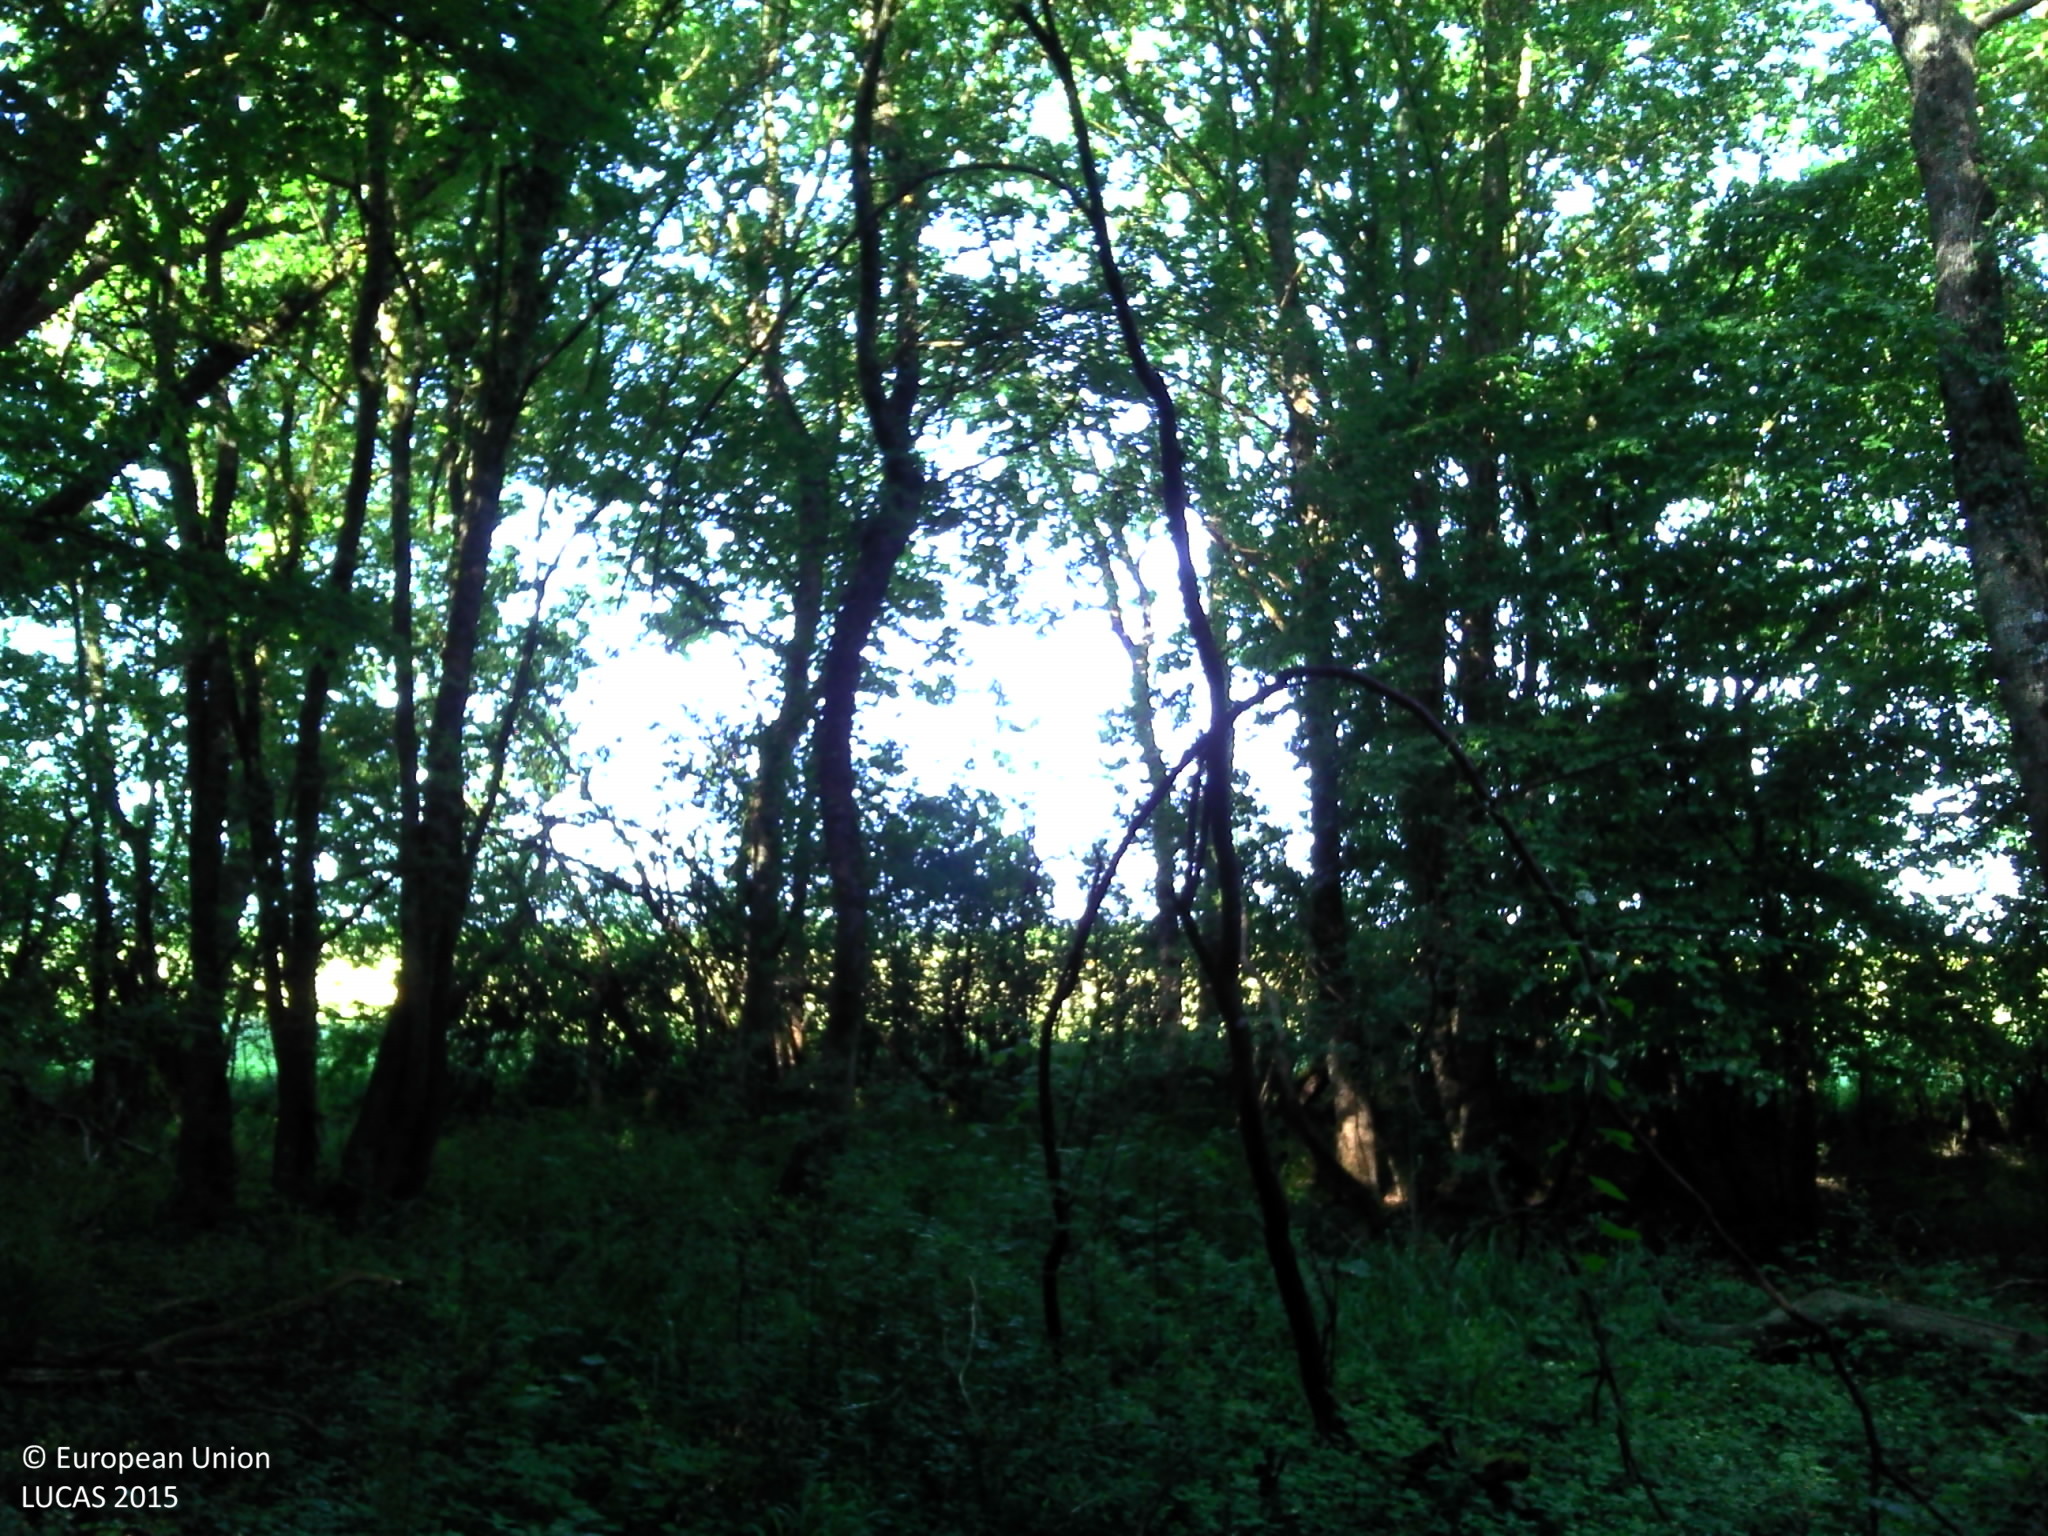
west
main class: Woodland
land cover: Broadleaved woodland
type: beech forest
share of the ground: > 75 %
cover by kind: broadleaved forest trees 90 %, herbaceous plants 10 %
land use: Forestry
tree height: > 5 m
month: June
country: FR
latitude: 46.9851
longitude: 2.9352
